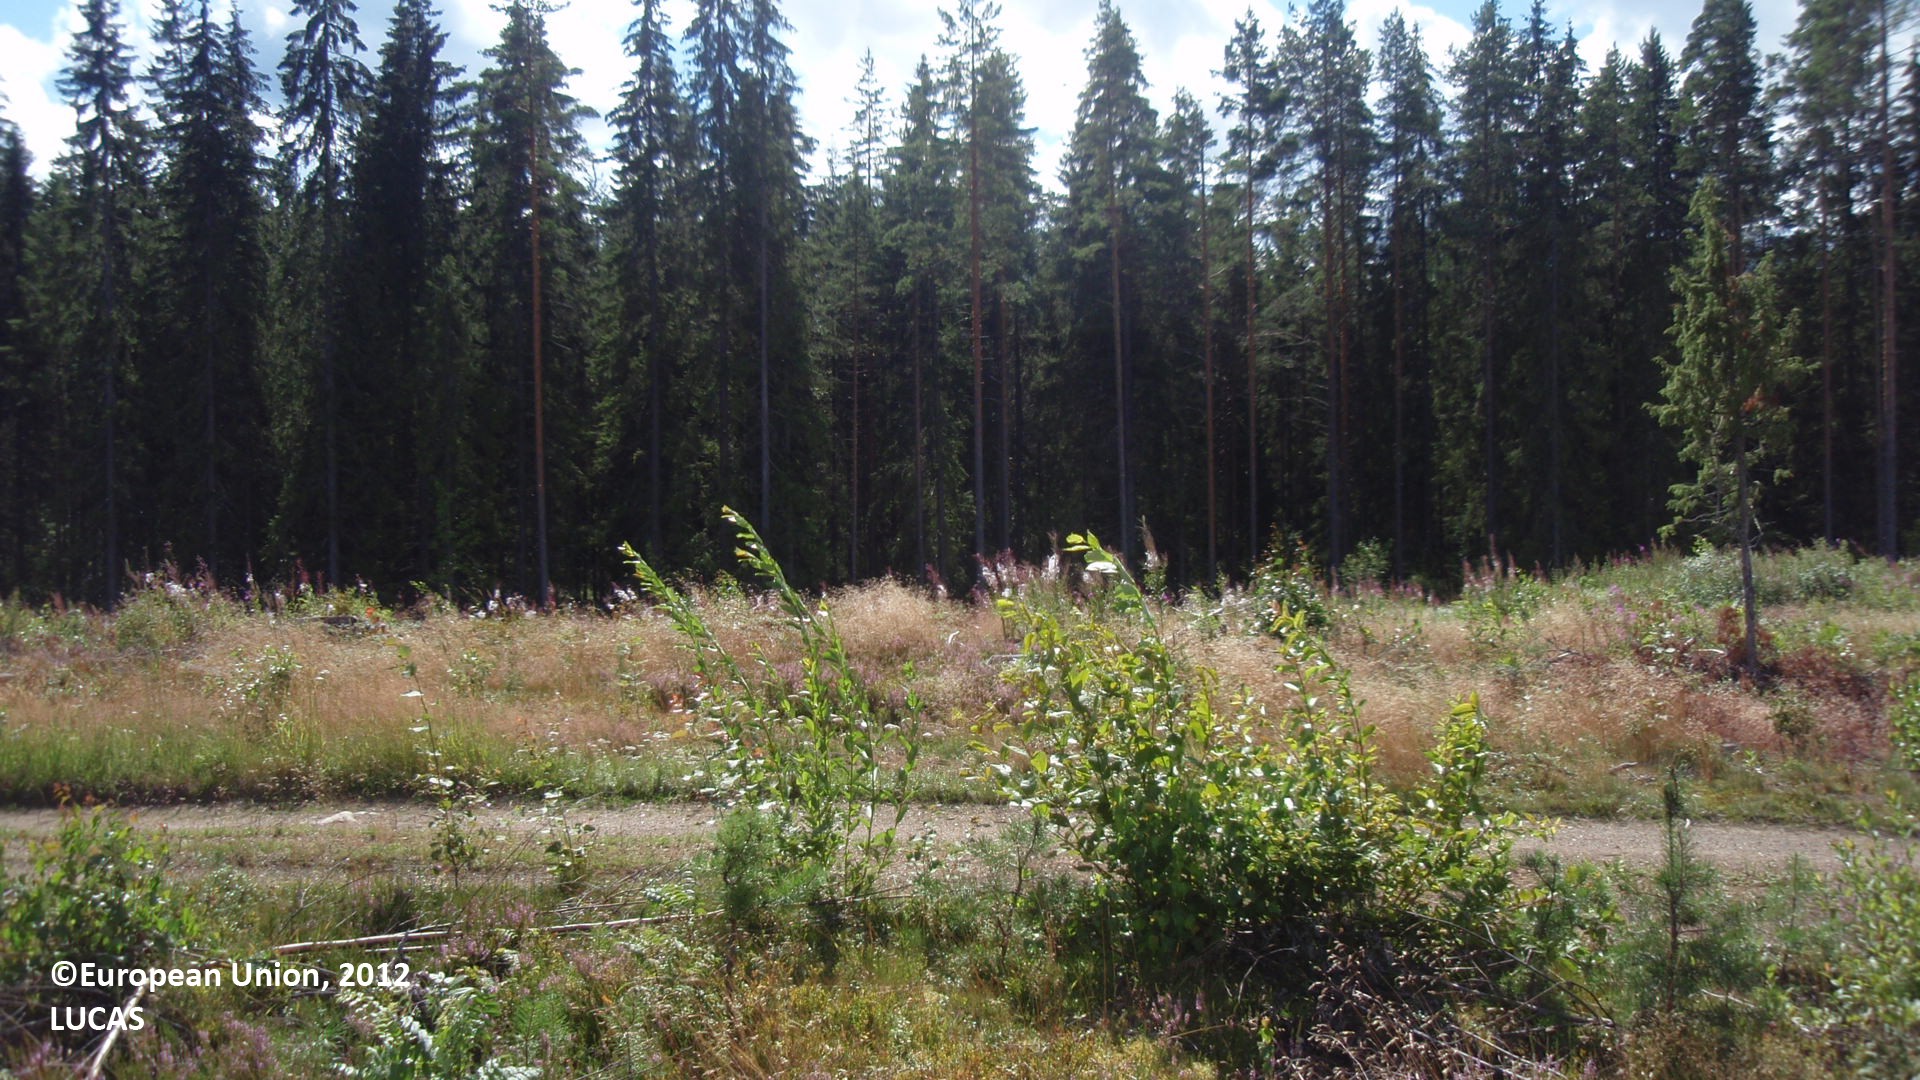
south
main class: Shrubland
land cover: Shrubland with sparse tree cover
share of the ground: 50 - 75 %
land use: Forestry
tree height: < 5 m
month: August
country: FI
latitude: 61.0492
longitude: 27.8422
